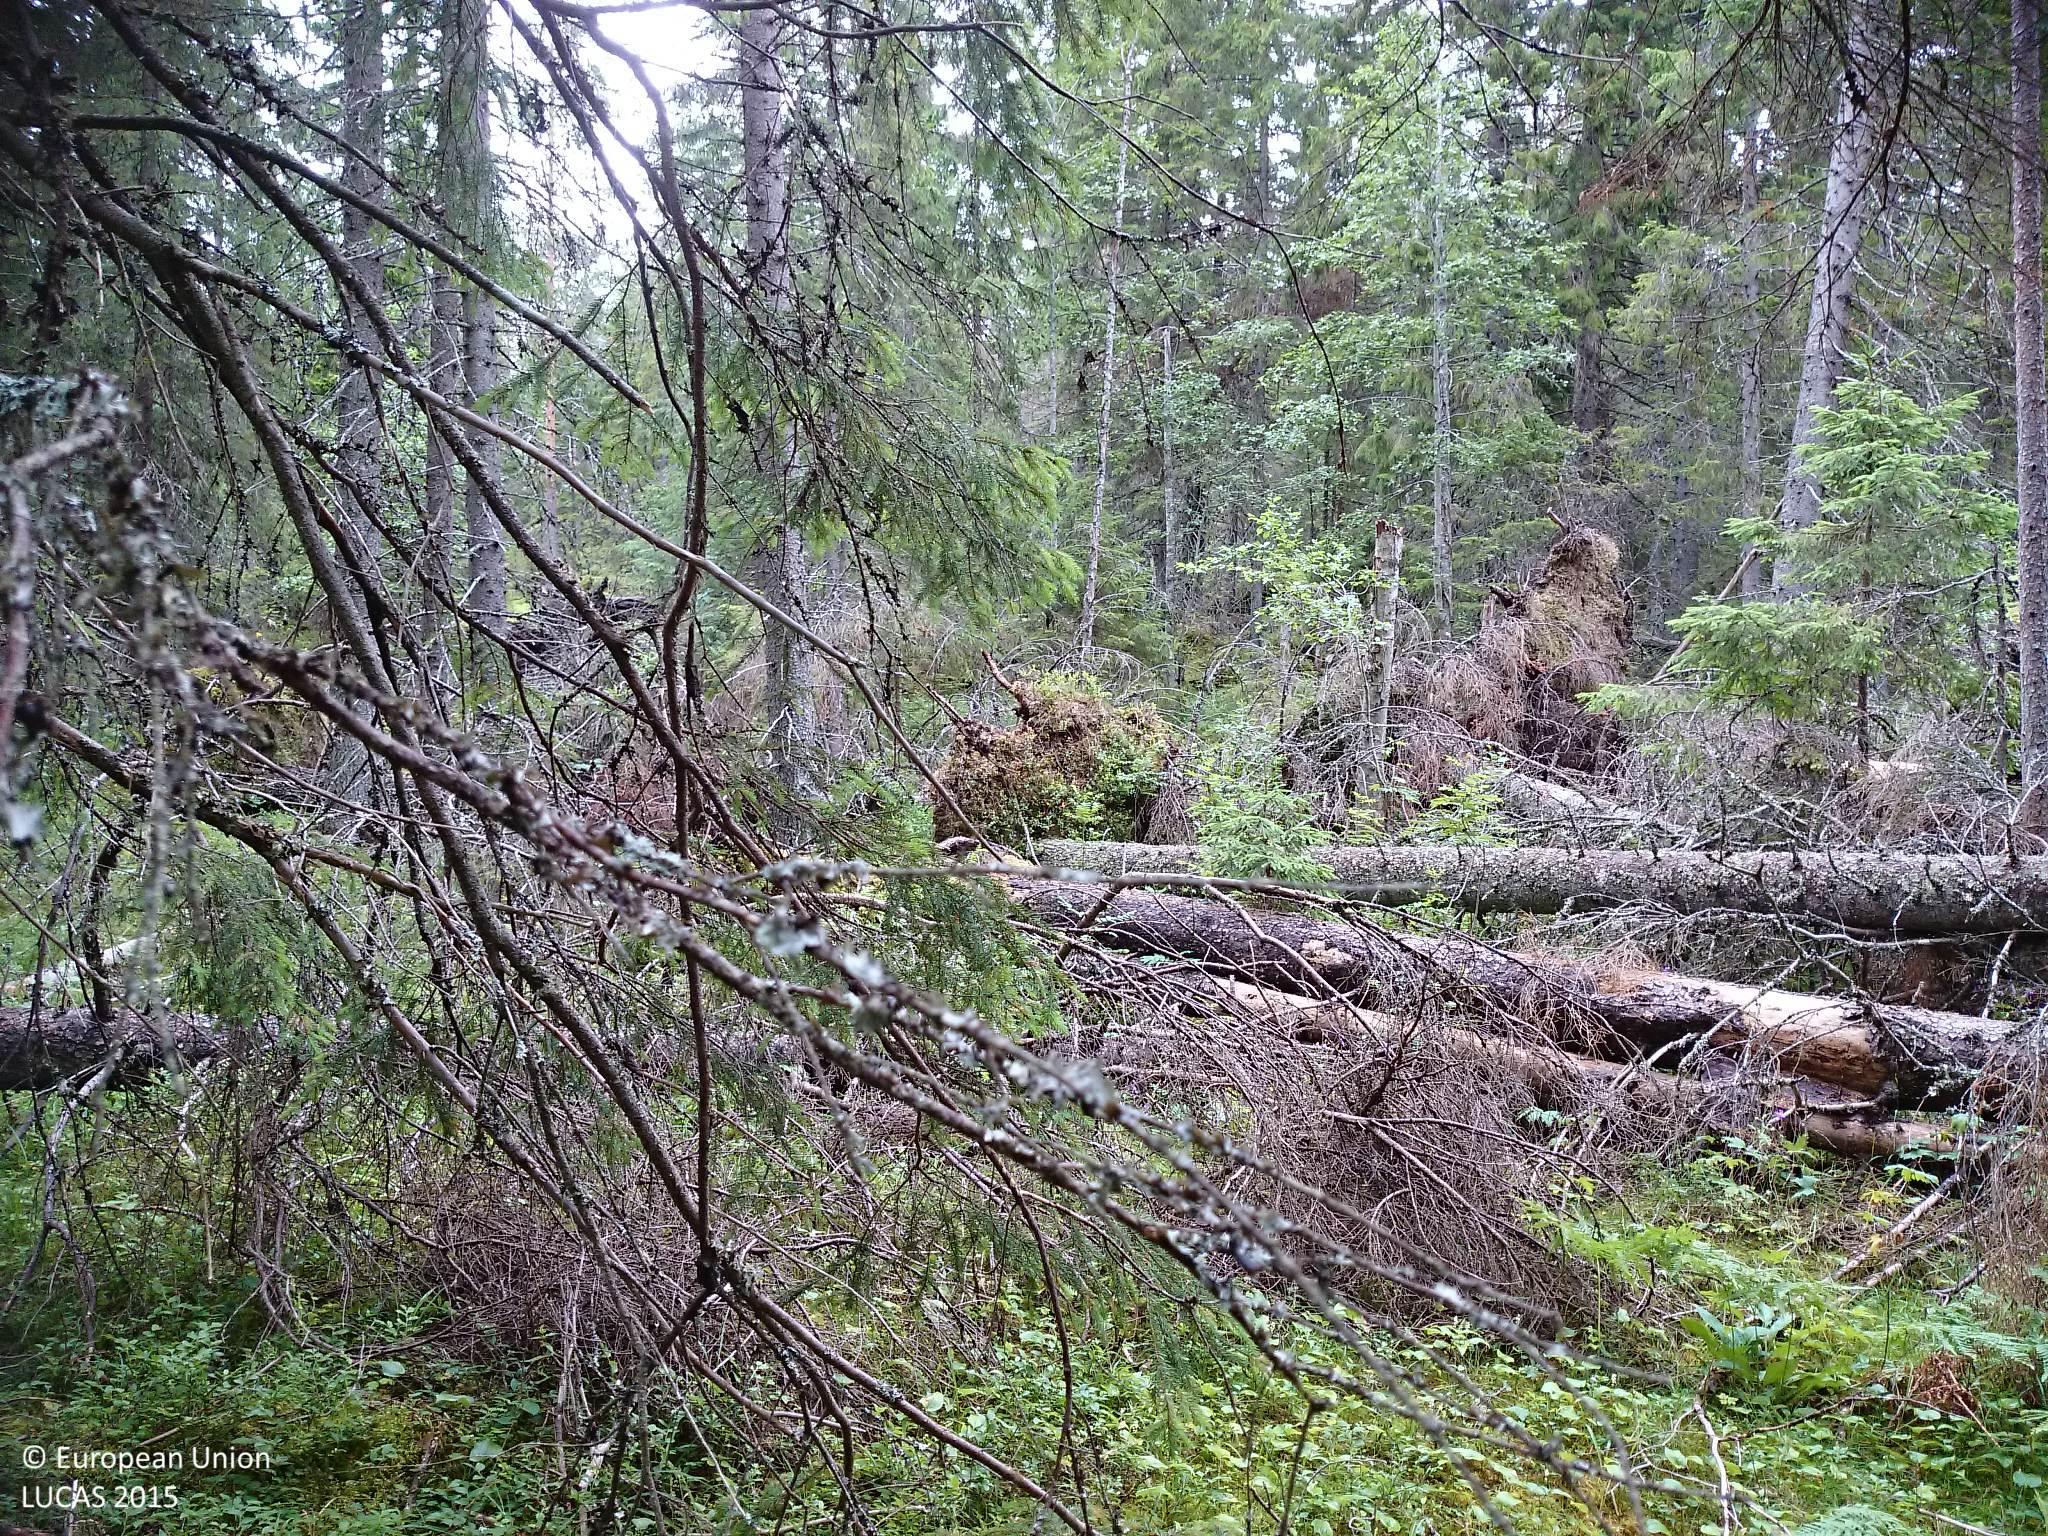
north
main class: Woodland
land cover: Spruce dominated coniferous woodland
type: boreal forest
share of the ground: 50 - 75 %
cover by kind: coniferous forest trees 60 %, shrubs 20 %, lichens and mosses 20 %
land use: Forestry
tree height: > 5 m
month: July
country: SE
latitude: 62.5184
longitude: 17.8088
